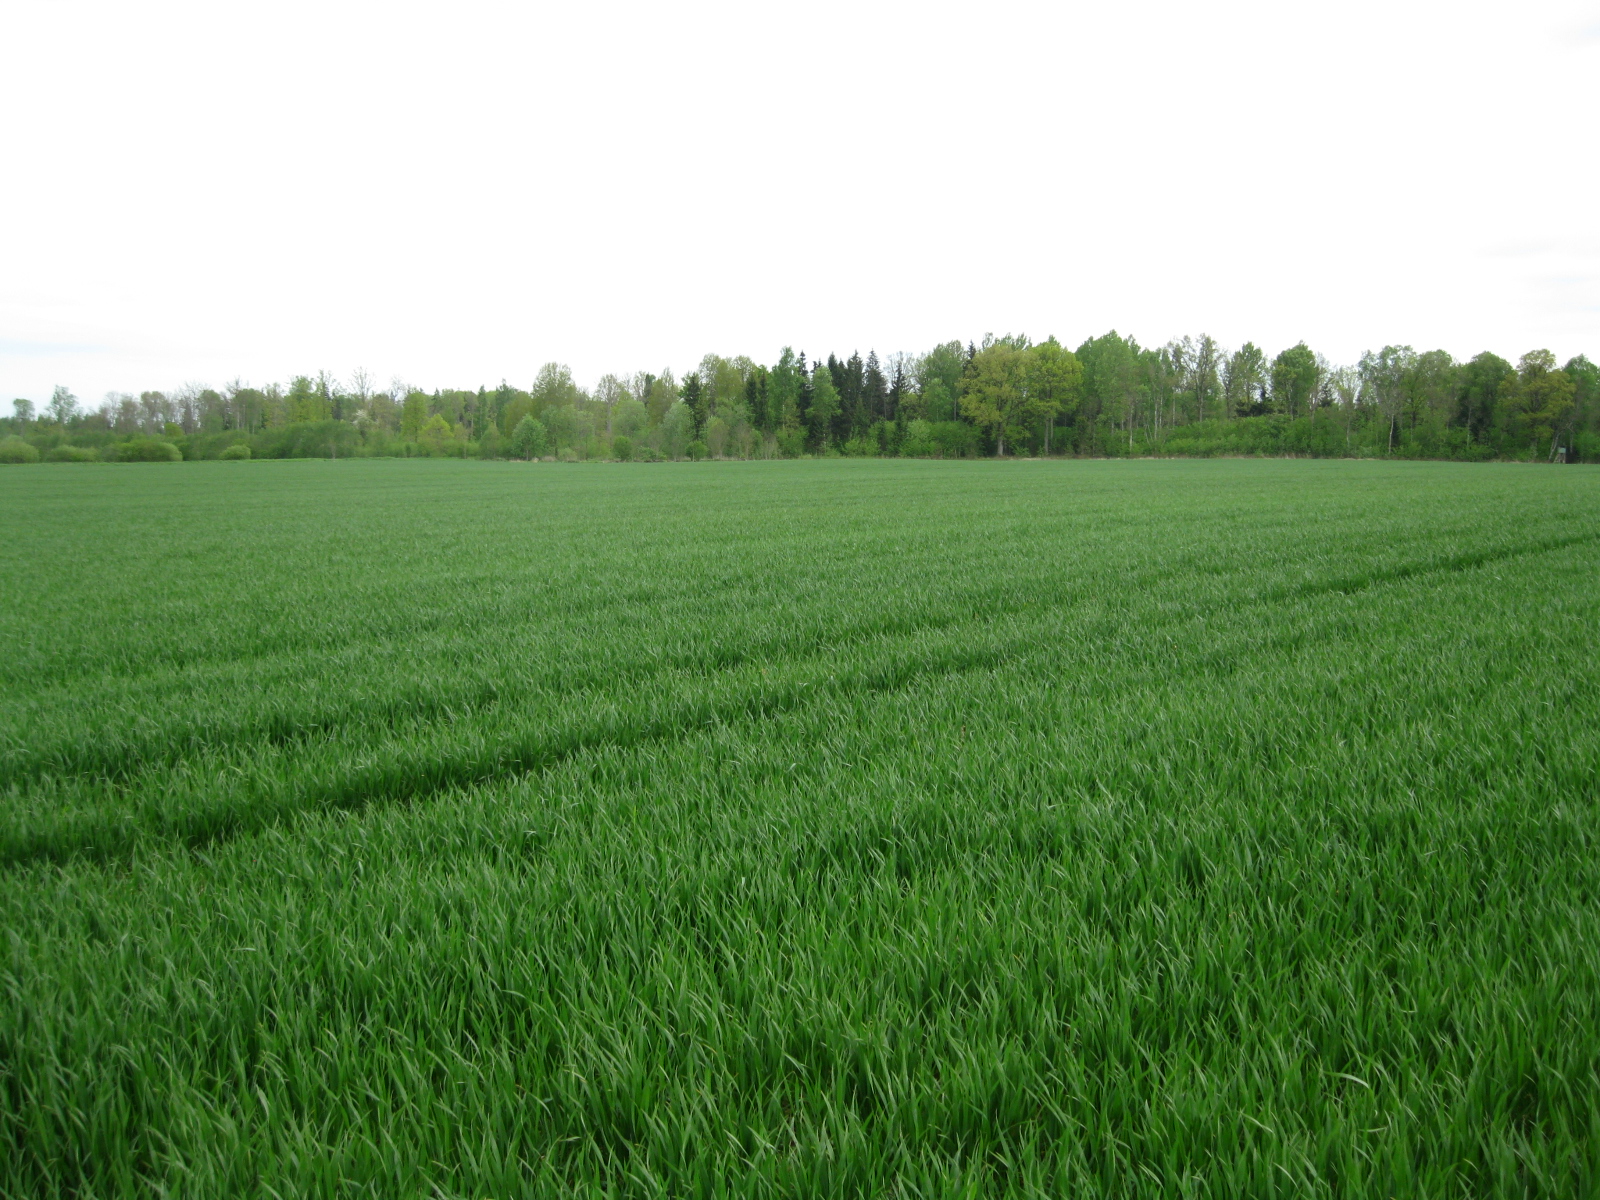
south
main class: Cropland
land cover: Barley
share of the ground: > 75 %
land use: Agriculture (excluding fallow land and kitchen gardens)
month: May
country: LT
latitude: 56.2101
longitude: 23.4078
